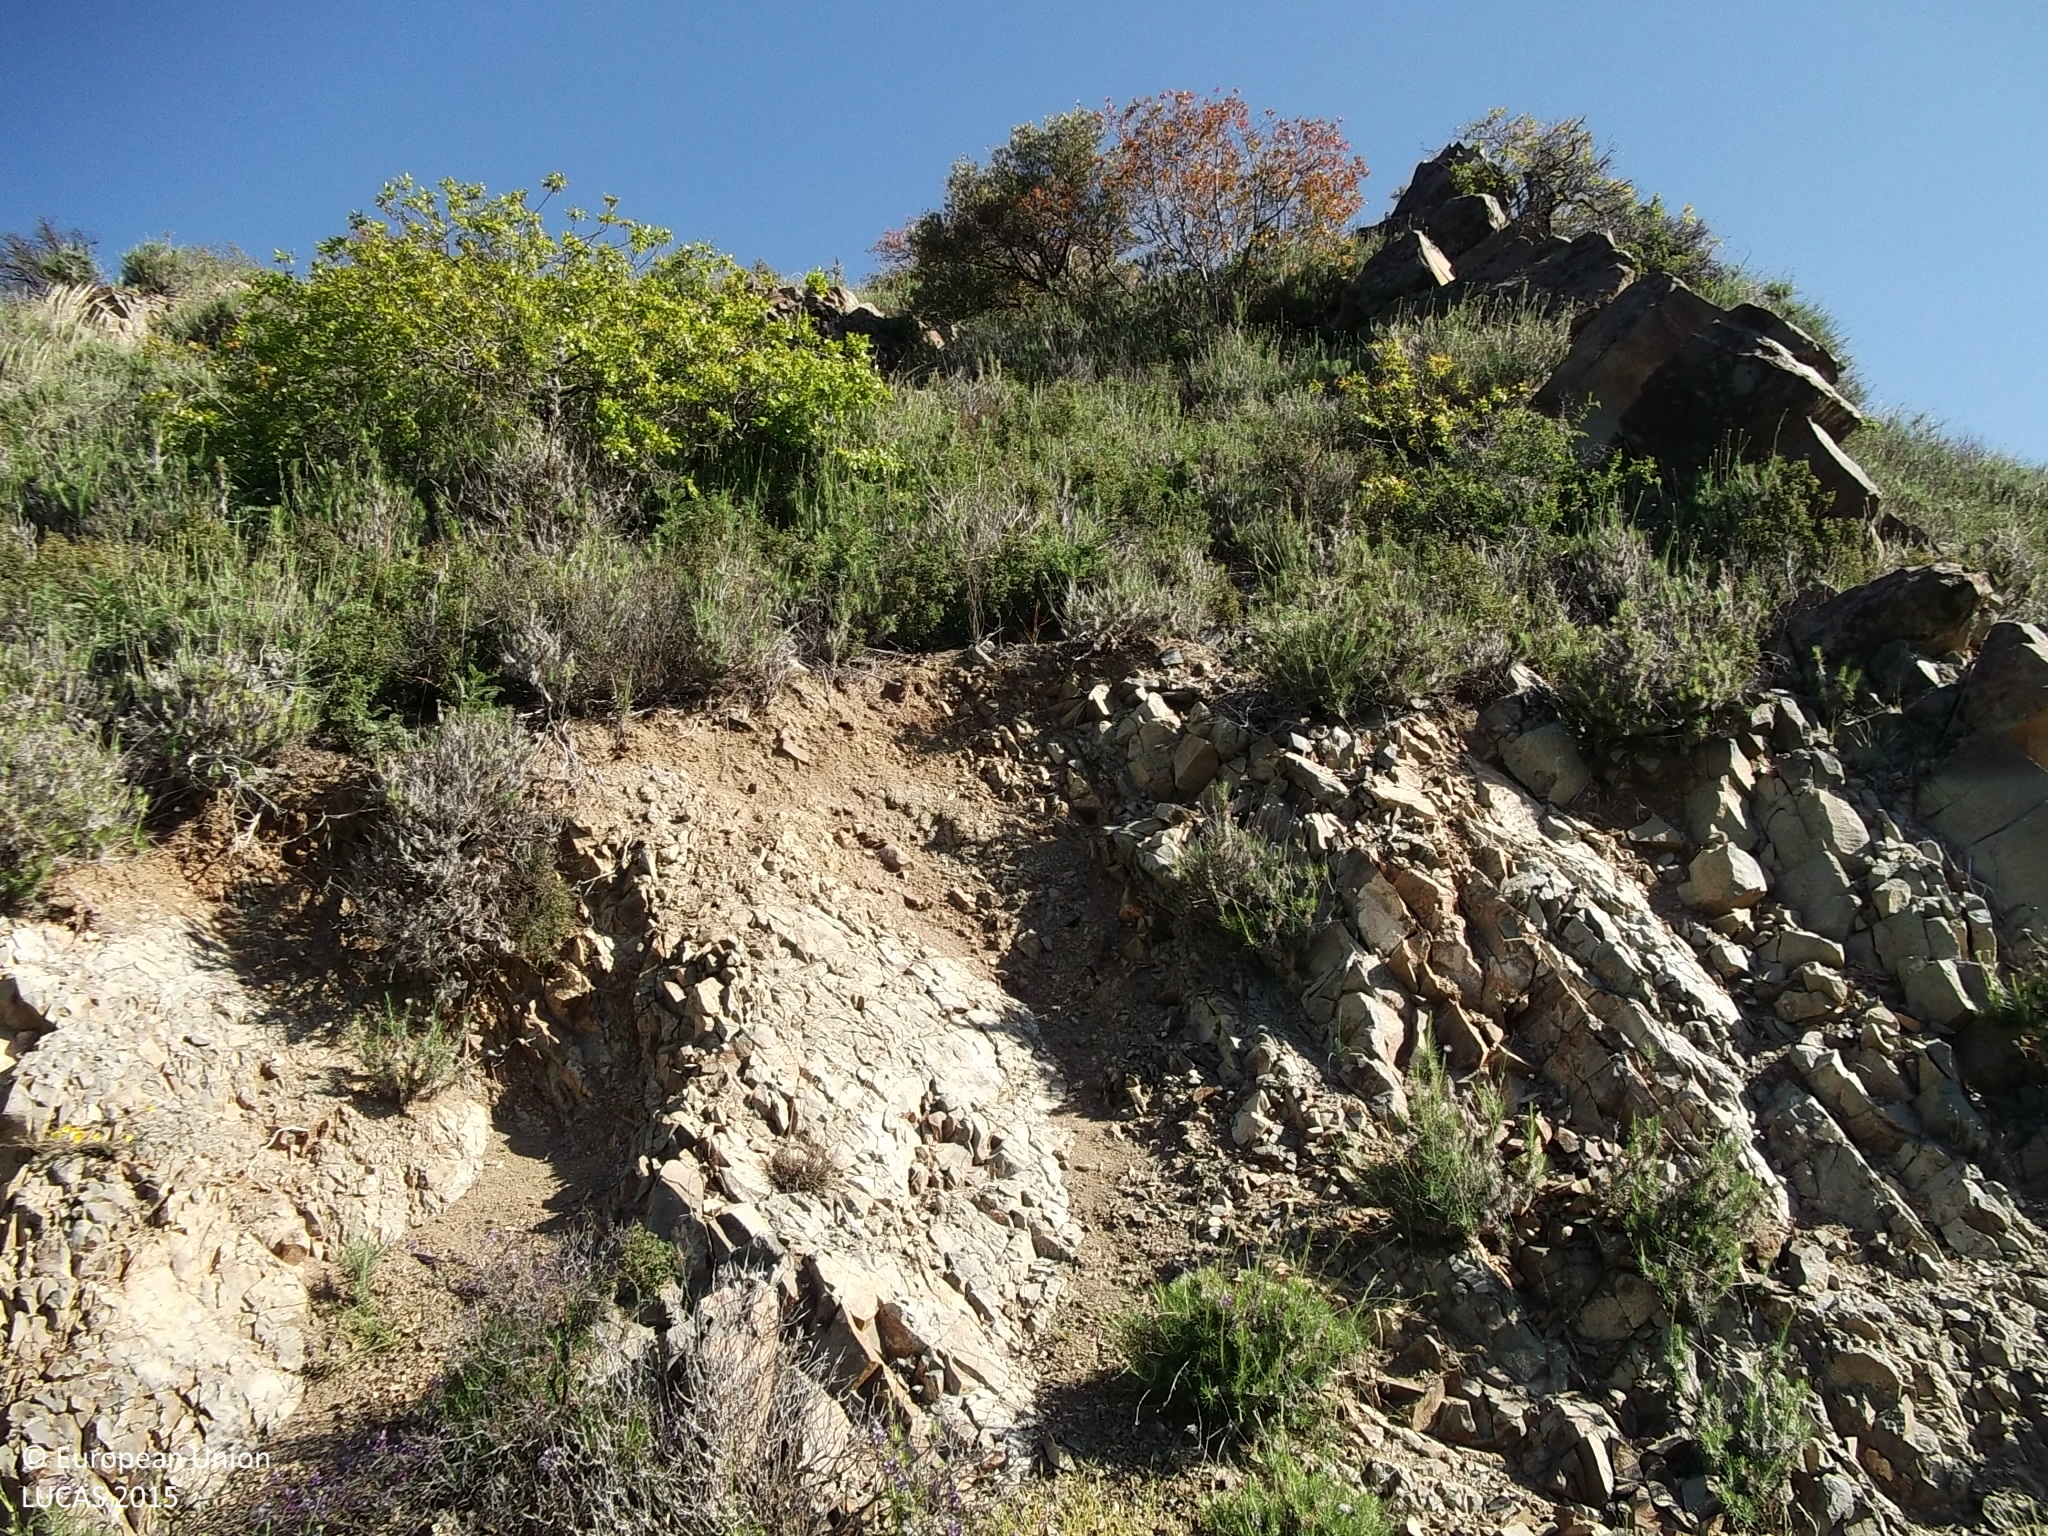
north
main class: Woodland
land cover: Pine dominated mixed woodland
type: coniferous forest of the mediterranean region
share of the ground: 10 - 25 %
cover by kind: shrubs 45 %, unconsolidated bare surface 30 %, coniferous forest trees 15 %, broadleaved forest trees 10 %
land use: Semi-natural and natural areas not in use
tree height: > 5 m
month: April
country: CY
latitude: 34.9341
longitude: 33.1121
